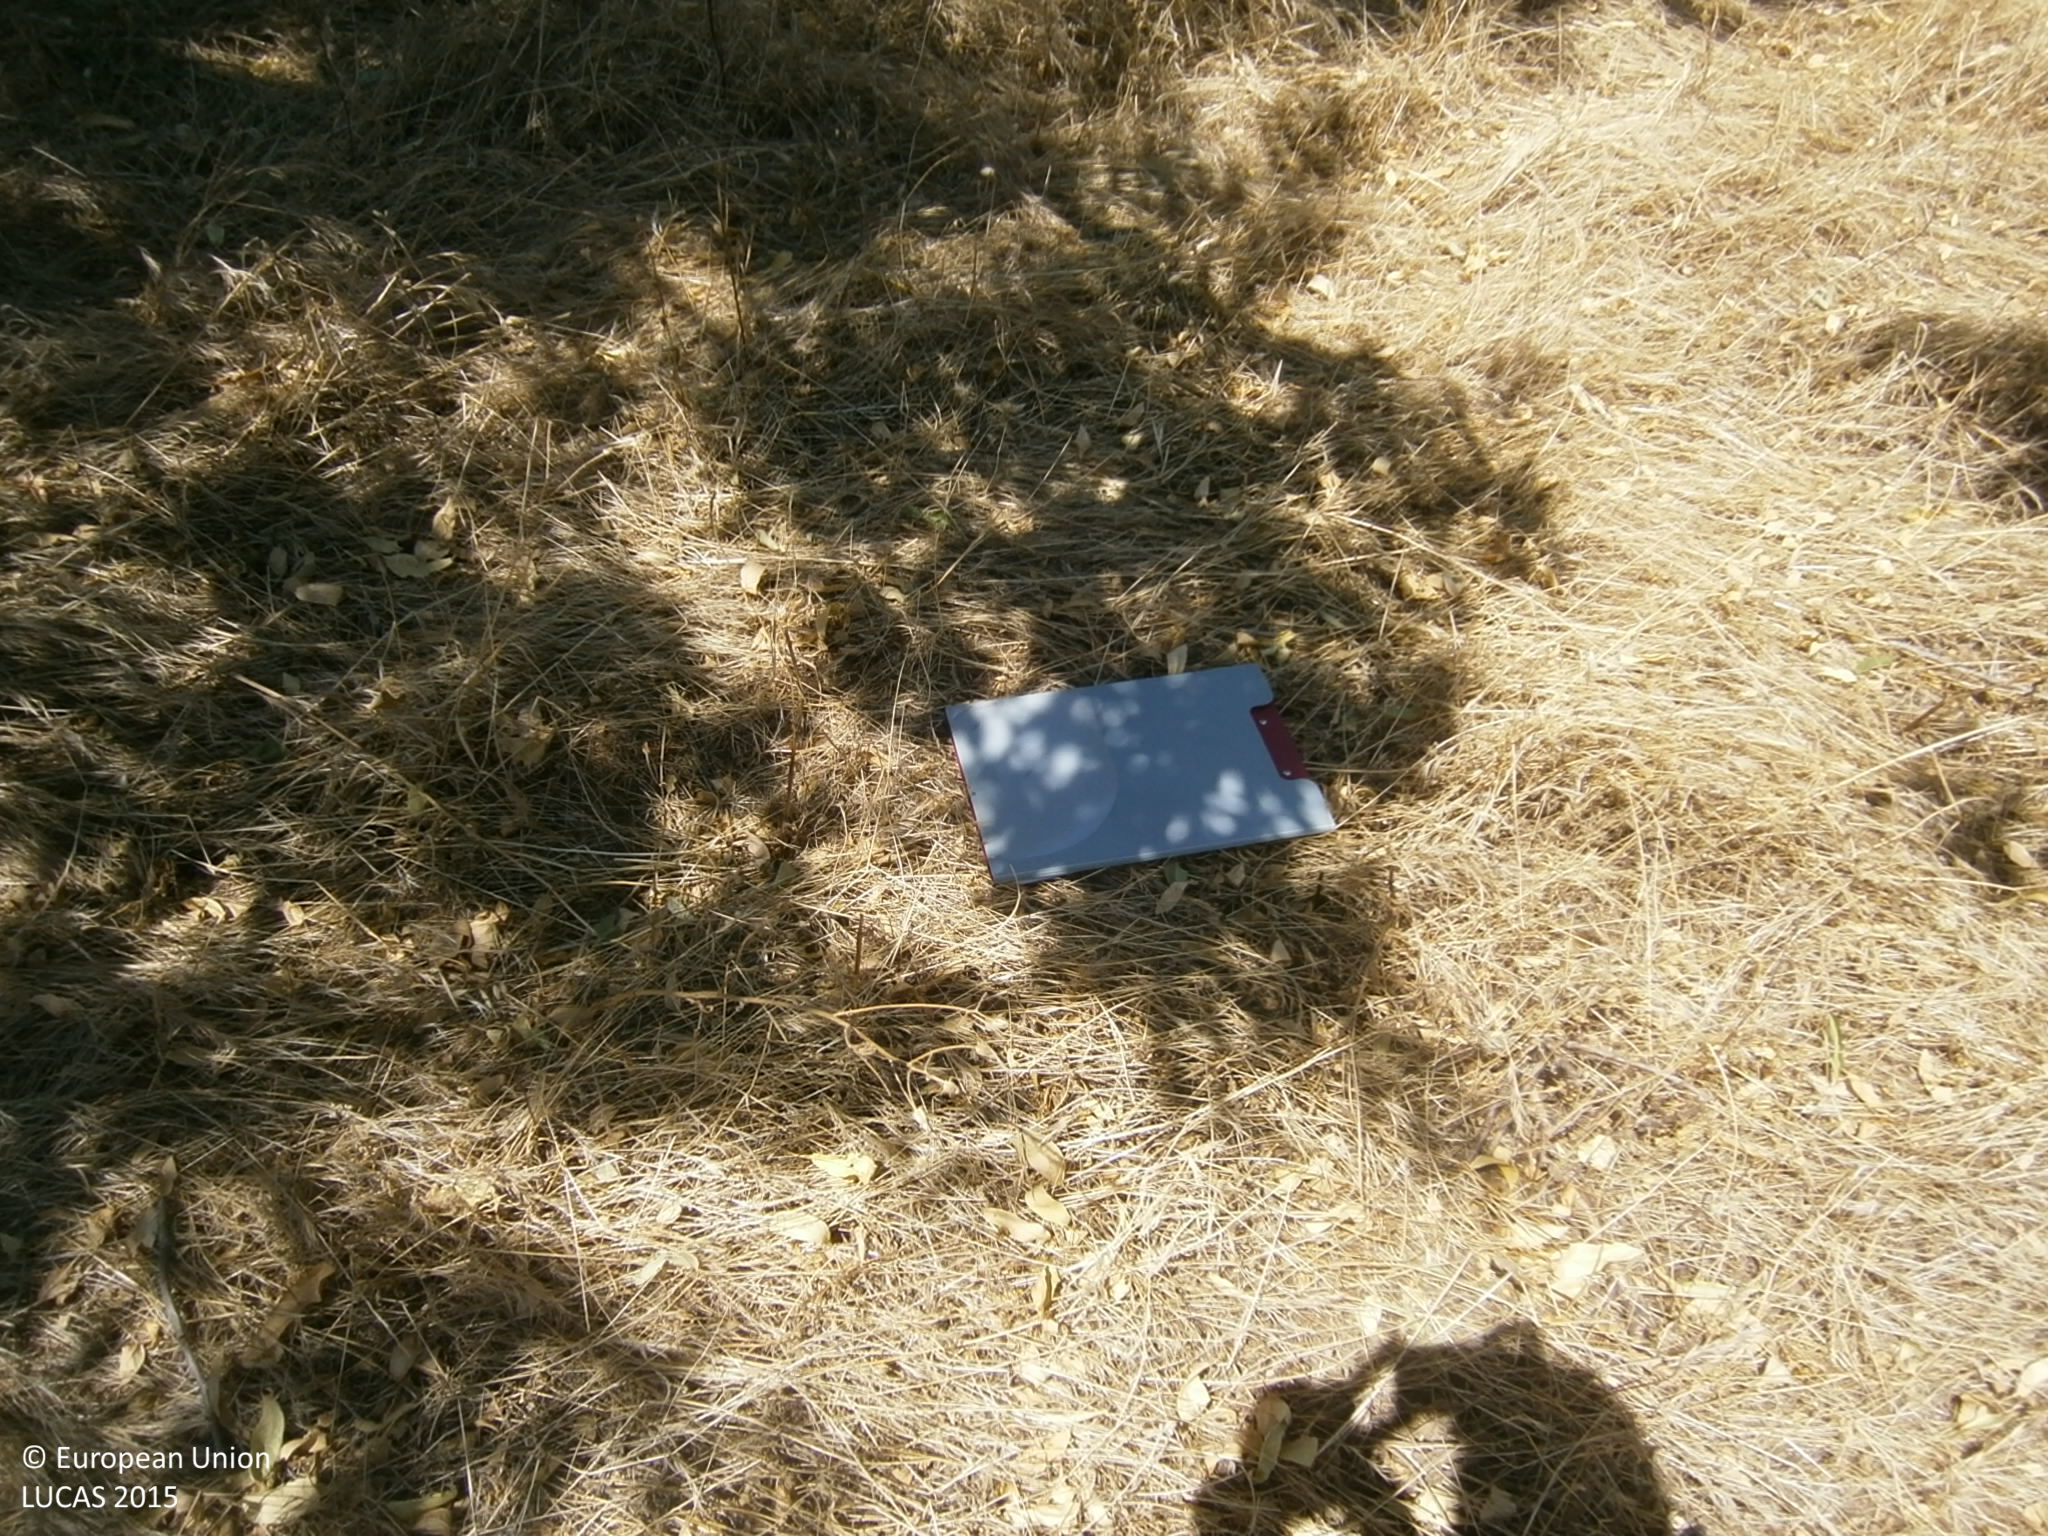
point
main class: Cropland
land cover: Nuts trees
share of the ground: > 75 %
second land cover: Spontaneously vegetated surfaces
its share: 25 - 50 %
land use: Agriculture (excluding fallow land and kitchen gardens)
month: June
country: ES
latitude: 38.8312
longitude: -6.6619
